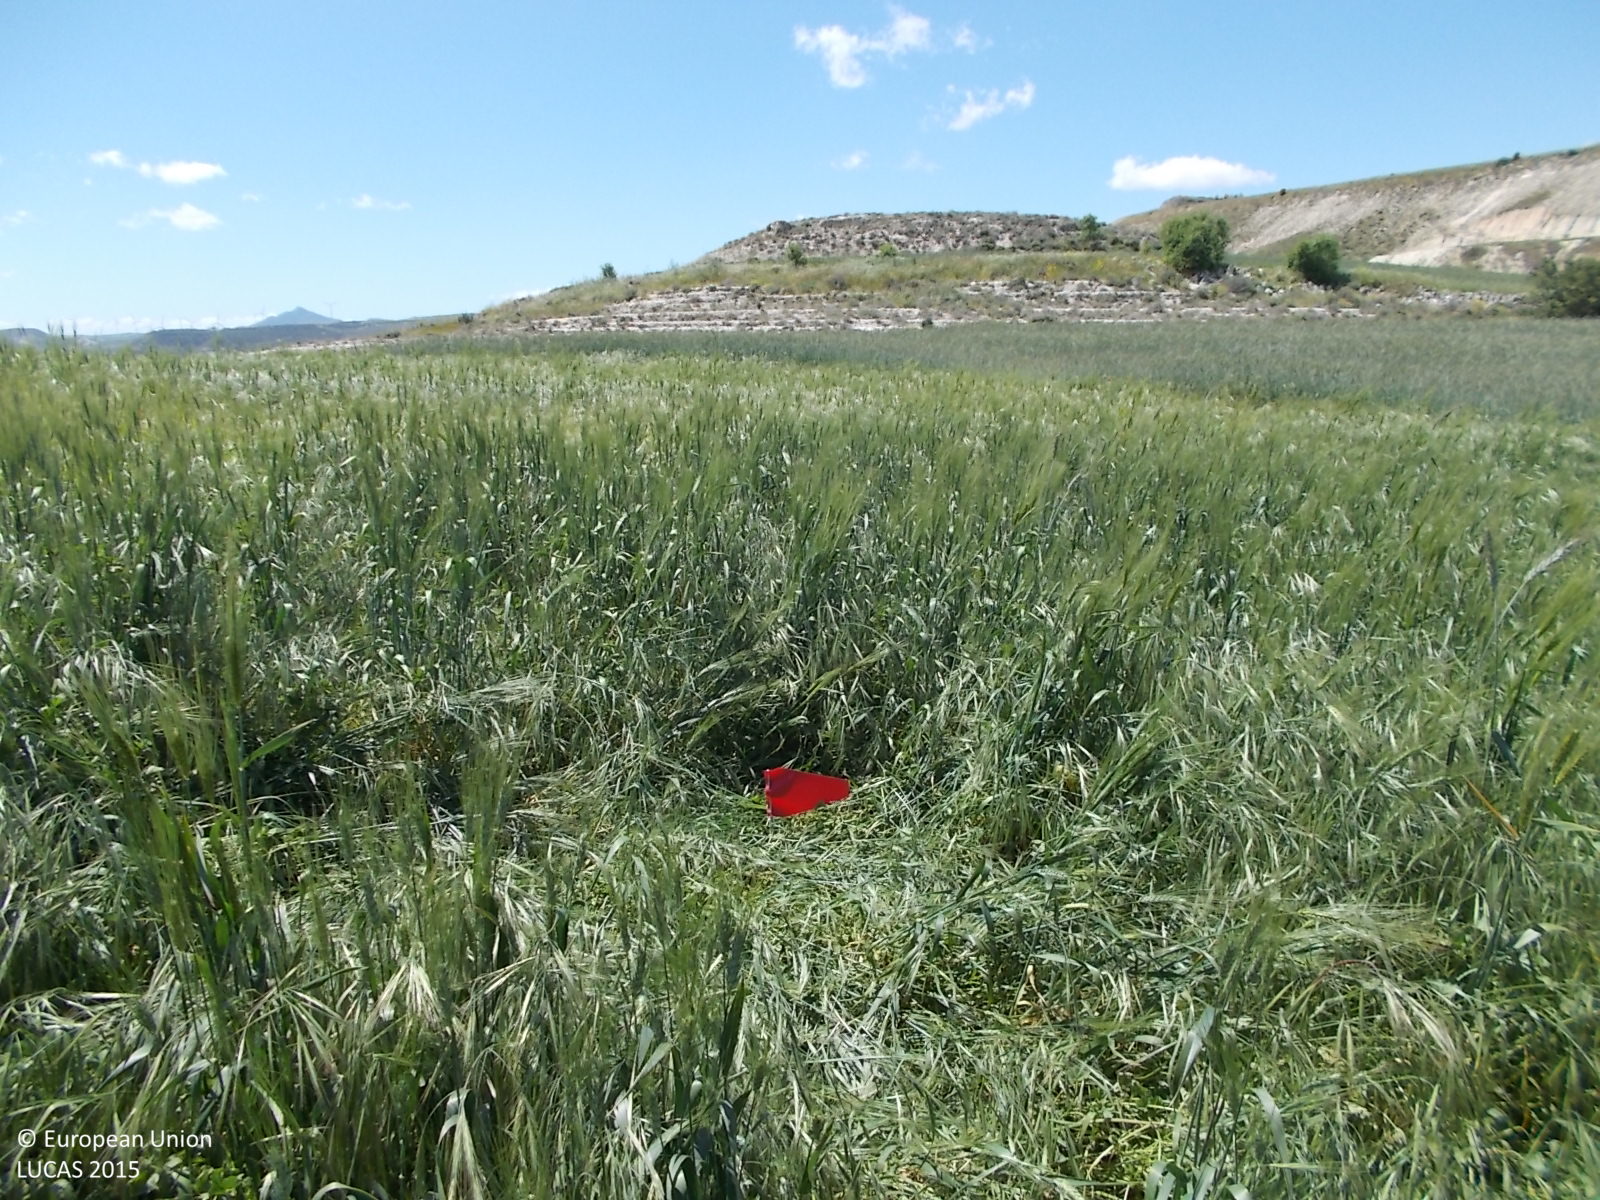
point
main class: Cropland
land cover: Mixed cereals for fodder
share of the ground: > 75 %
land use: Agriculture (excluding fallow land and kitchen gardens)
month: April
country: CY
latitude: 35.0144
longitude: 33.5265
